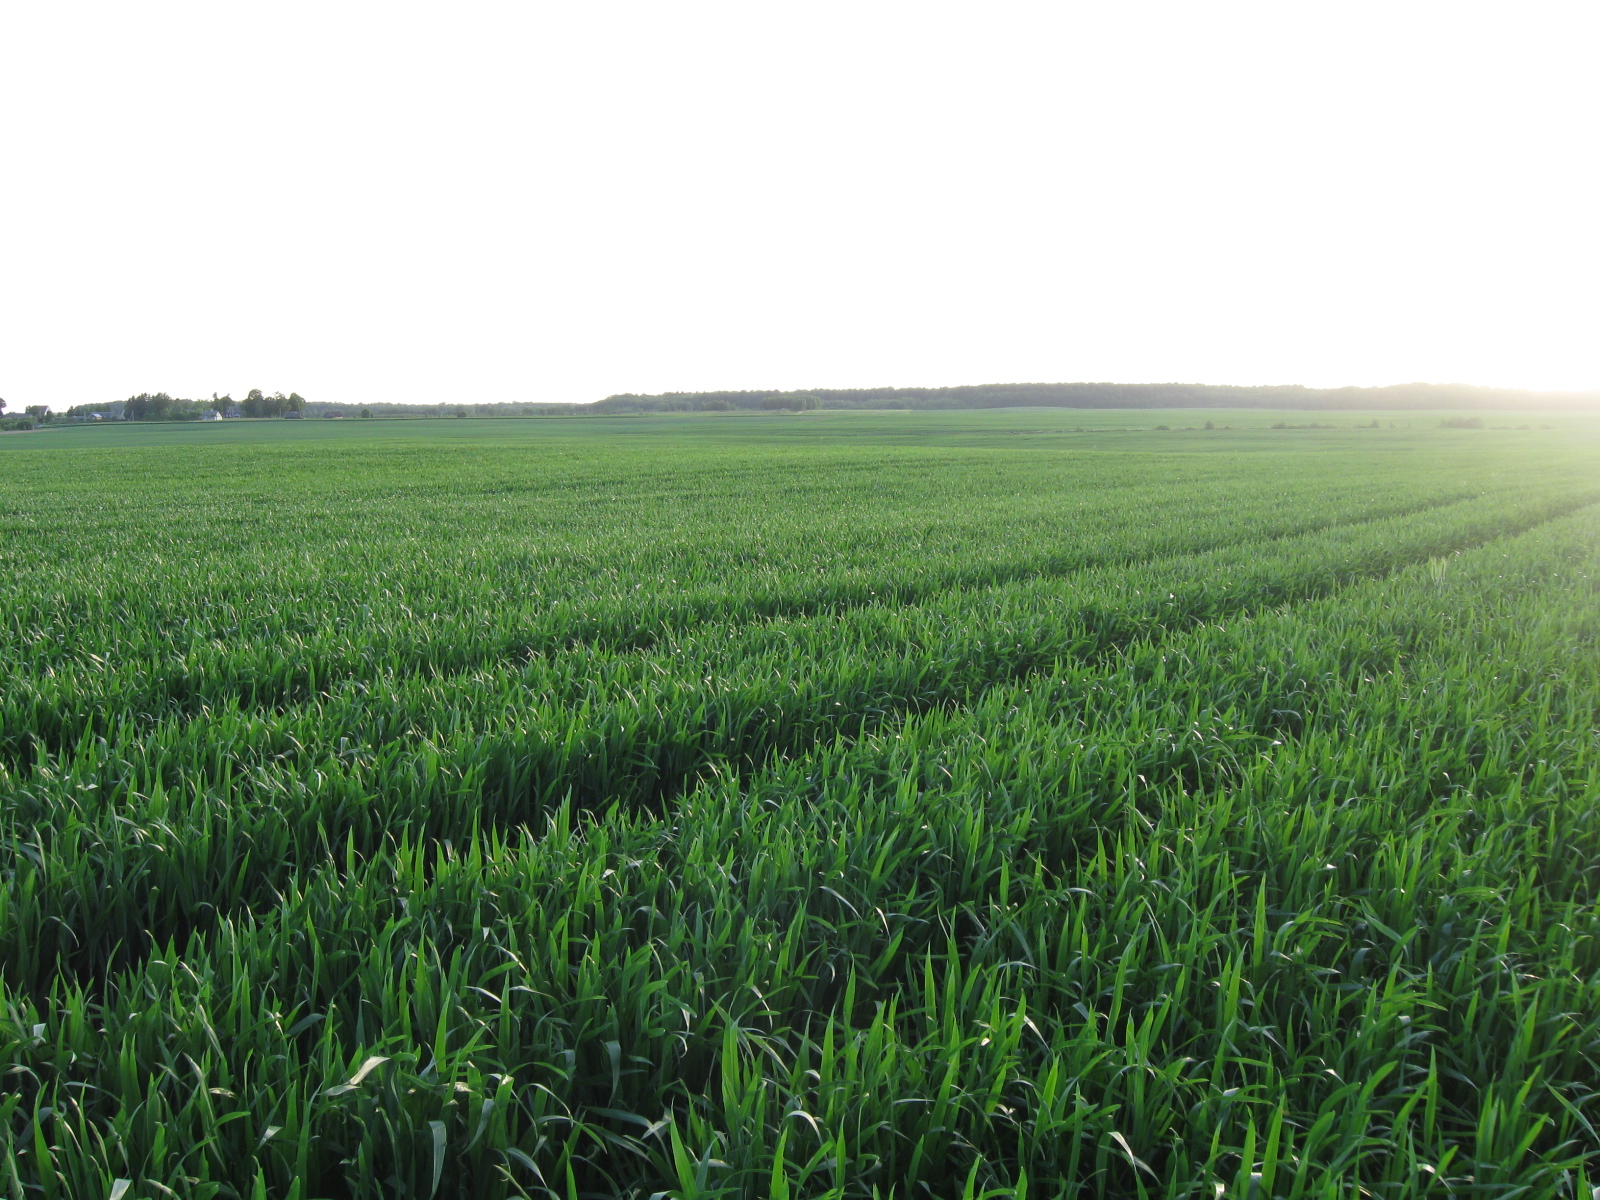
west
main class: Cropland
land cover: Common wheat
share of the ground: > 75 %
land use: Agriculture (excluding fallow land and kitchen gardens)
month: June
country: LT
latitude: 55.0384
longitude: 24.0977
